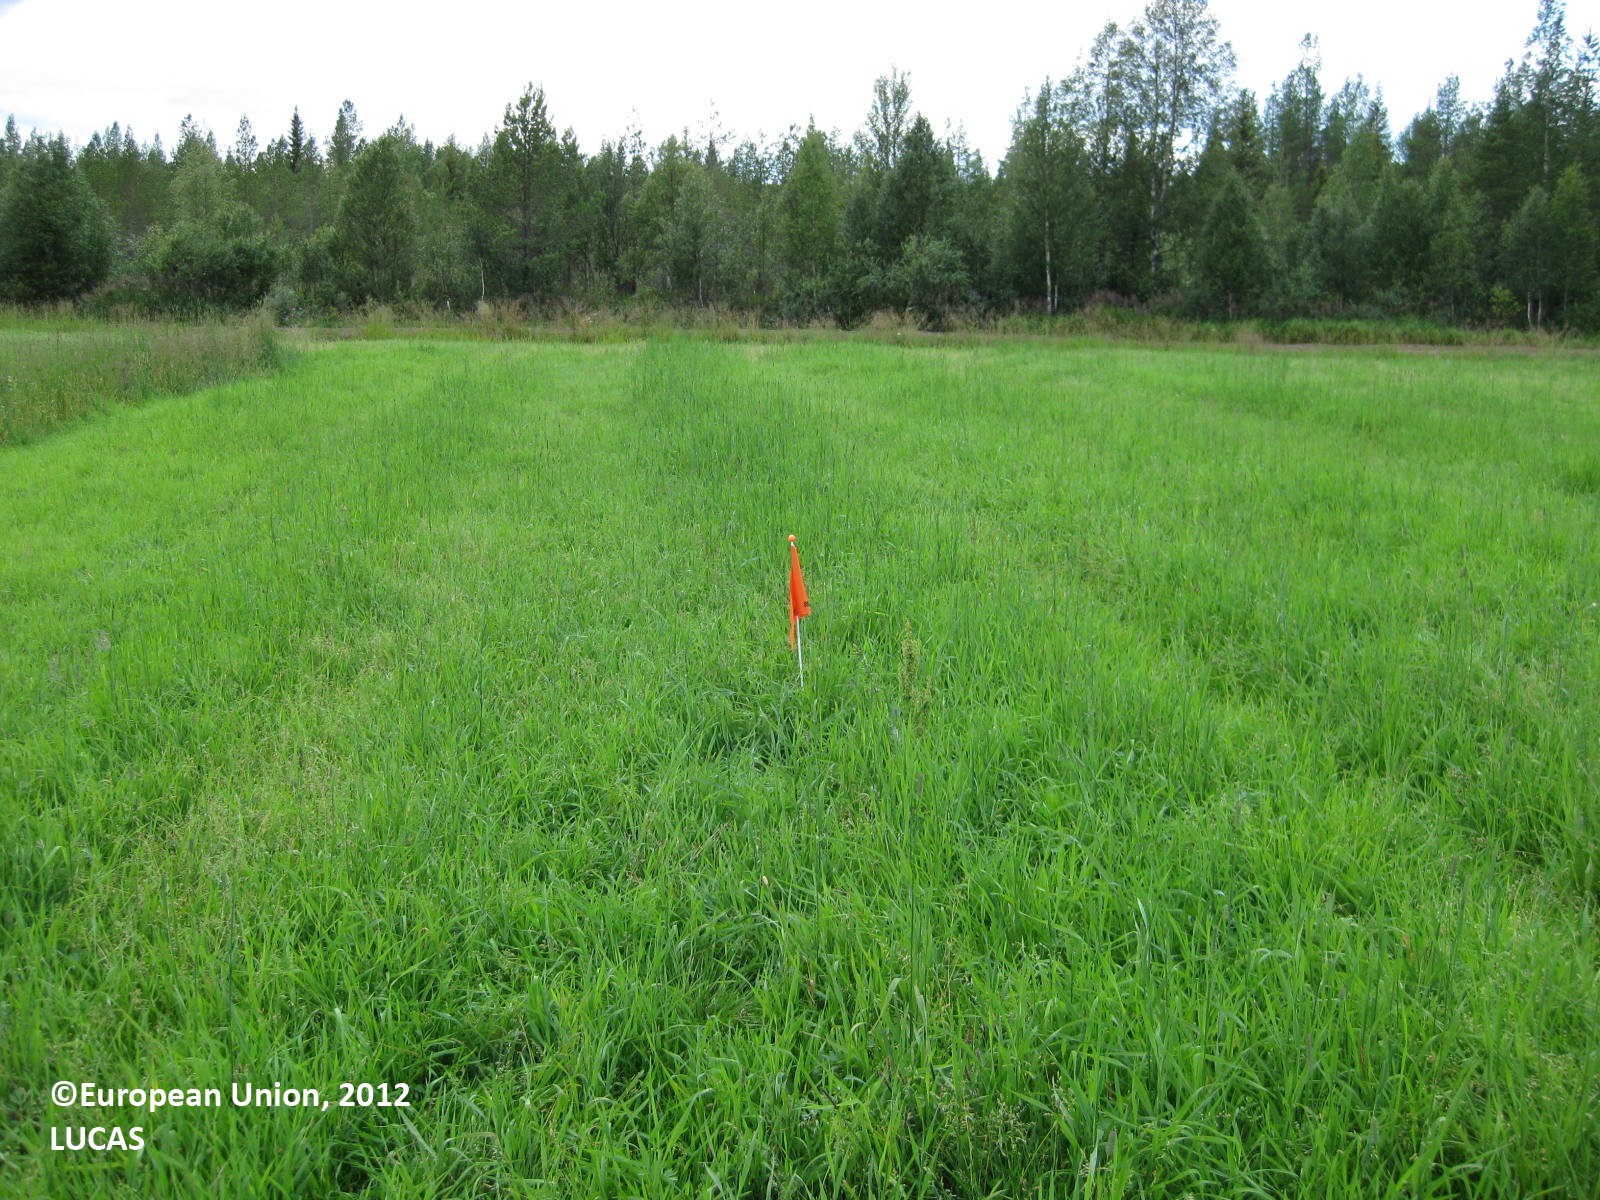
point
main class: Cropland
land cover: Temporary grasslands
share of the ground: > 75 %
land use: Agriculture (excluding fallow land and kitchen gardens)
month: August
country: FI
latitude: 66.4359
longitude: 28.5061
